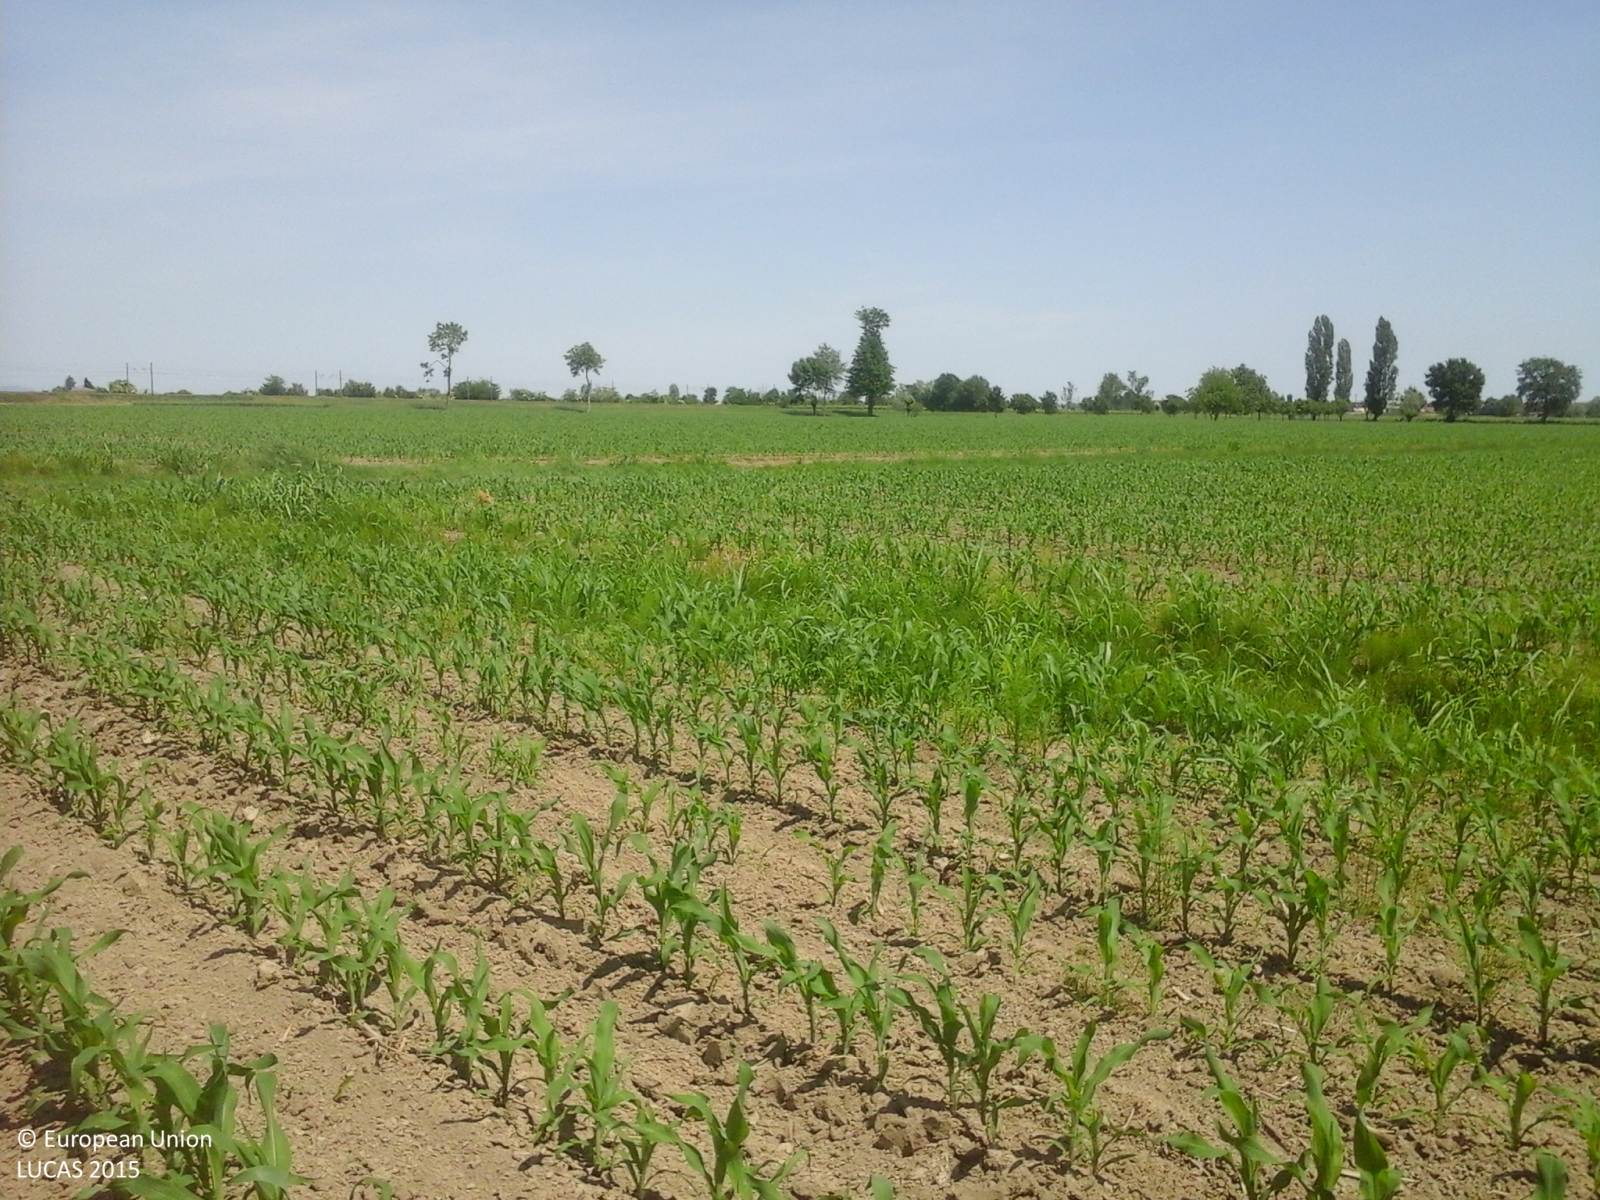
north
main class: Cropland
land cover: Maize
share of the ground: 10 - 25 %
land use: Agriculture (excluding fallow land and kitchen gardens)
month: May
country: IT
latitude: 44.9317
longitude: 11.7073
